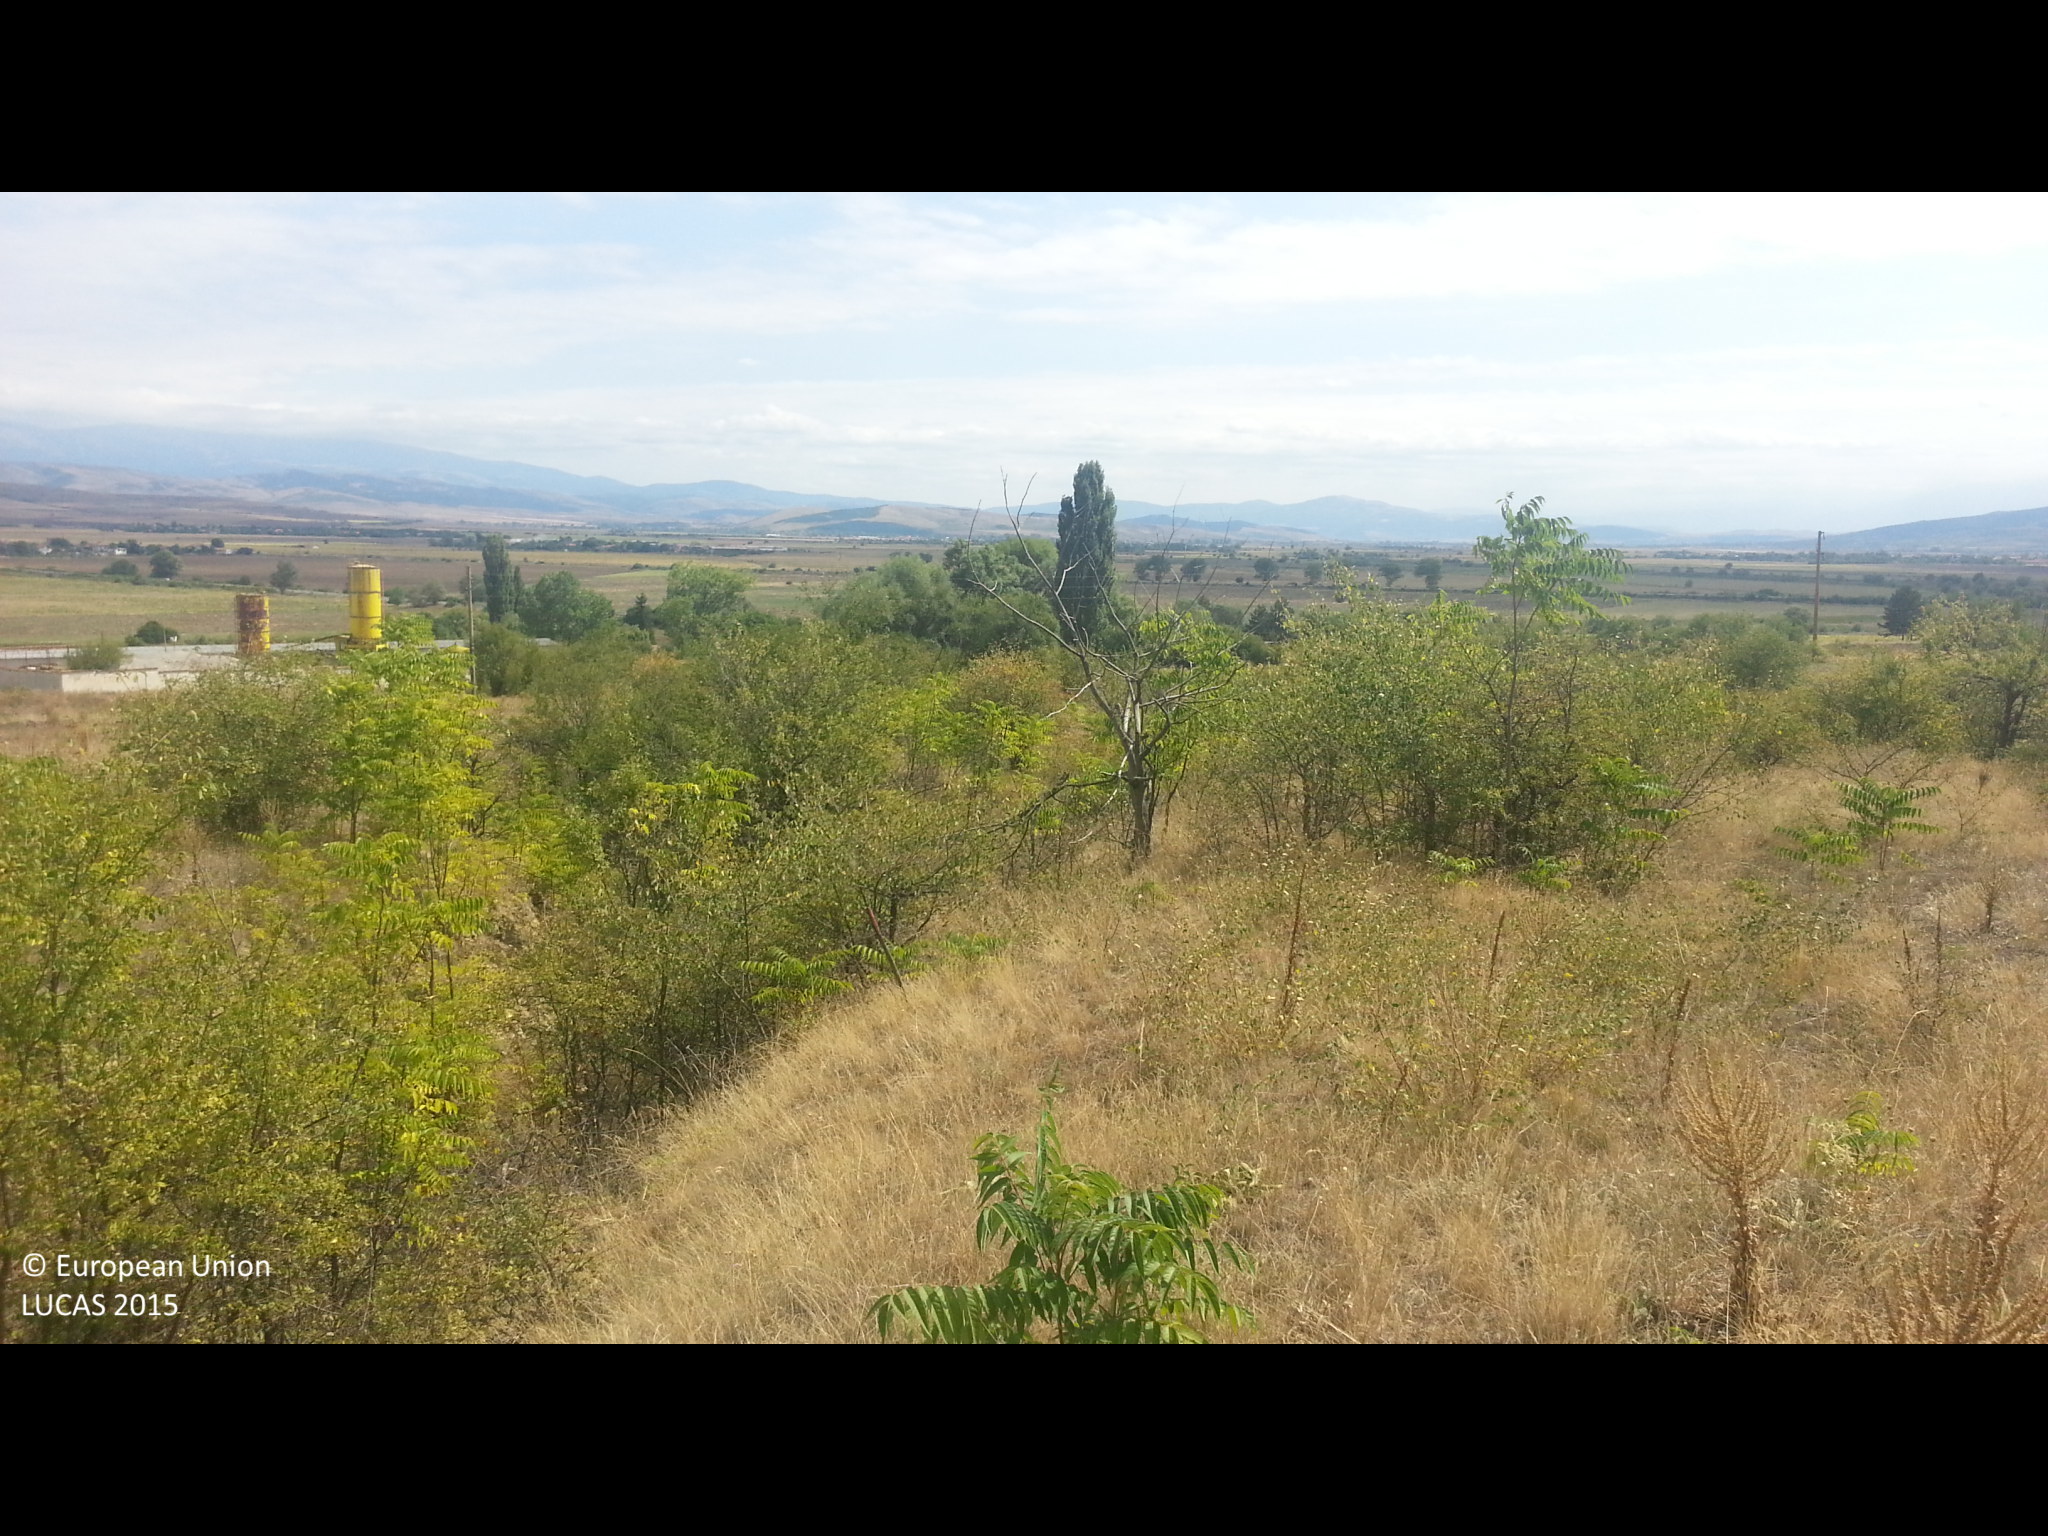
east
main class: Grassland
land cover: Grassland with sparse tree/shrub cover
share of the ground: > 75 %
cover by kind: herbaceous plants 90 %, broadleaved forest trees 5 %, shrubs 5 %
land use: Agriculture (excluding fallow land and kitchen gardens)
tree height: < 5 m
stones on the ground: 10 - 25 %
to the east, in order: Grassland with sparse tree/shrub cover; Ditches and canals; Grassland with sparse tree/shrub cover; Ditches and canals; Grassland with sparse tree/shrub cover; Paved roads, cycling and walking lanes; Grass margins; Fences; Grassland with sparse tree/shrub cover
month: September
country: BG
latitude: 42.4816
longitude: 22.9092
